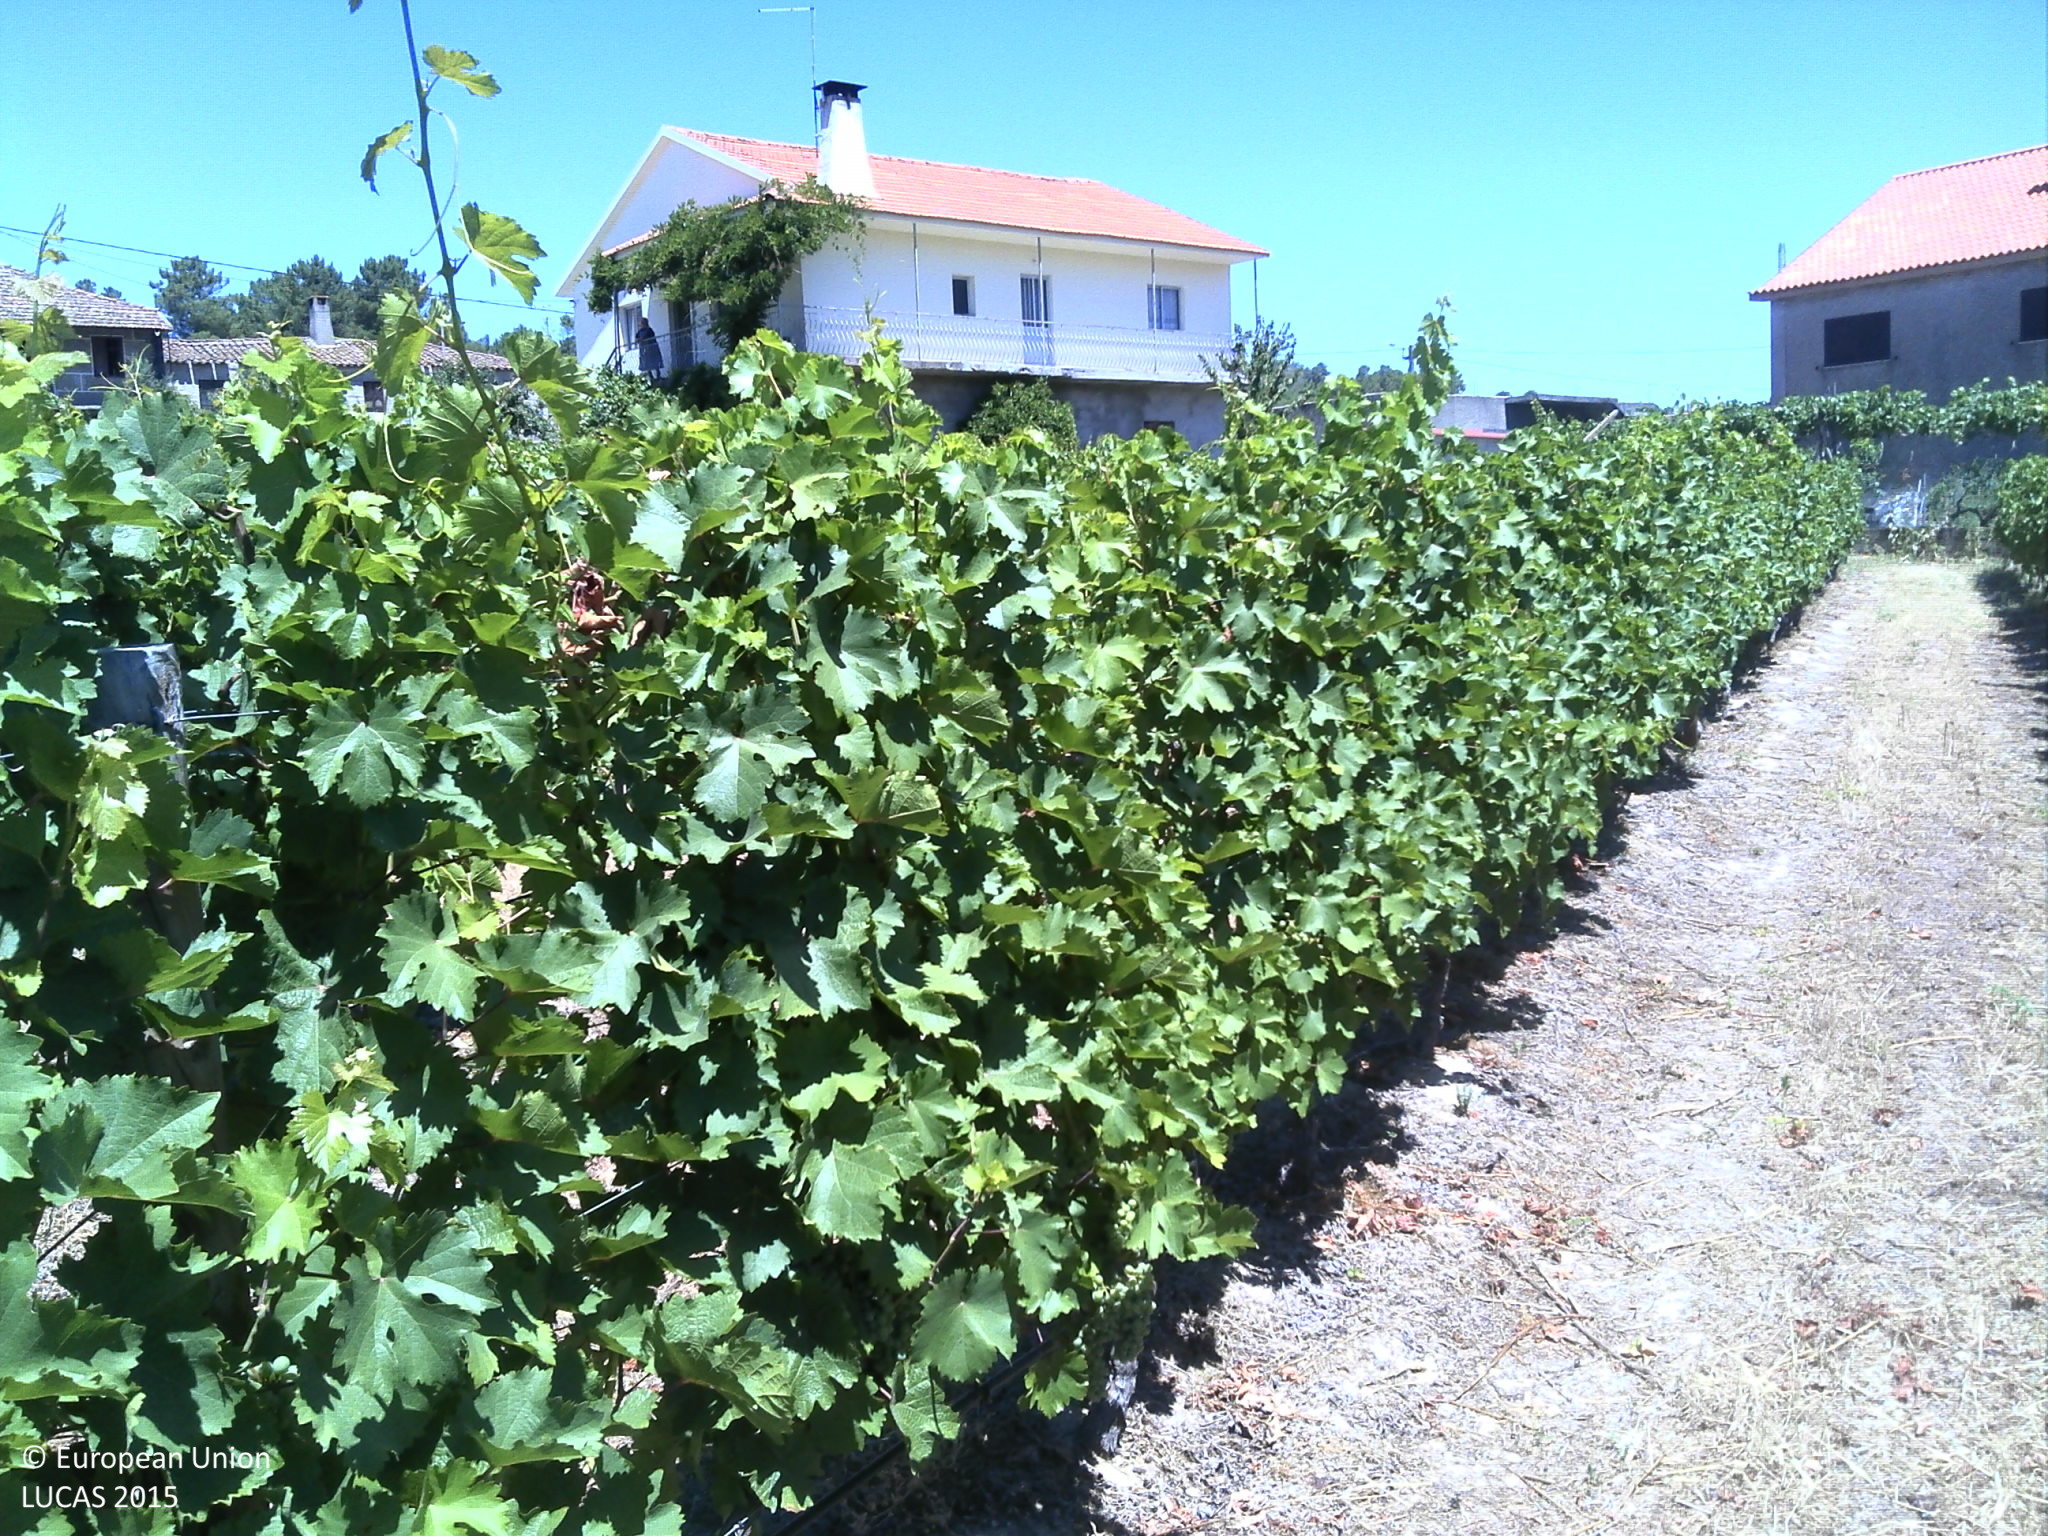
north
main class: Cropland
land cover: Vineyards
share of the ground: < 10 %
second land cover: Other bare soil
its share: > 75 %
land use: Agriculture (excluding fallow land and kitchen gardens)
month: July
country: PT
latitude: 41.2770
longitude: -7.3227
